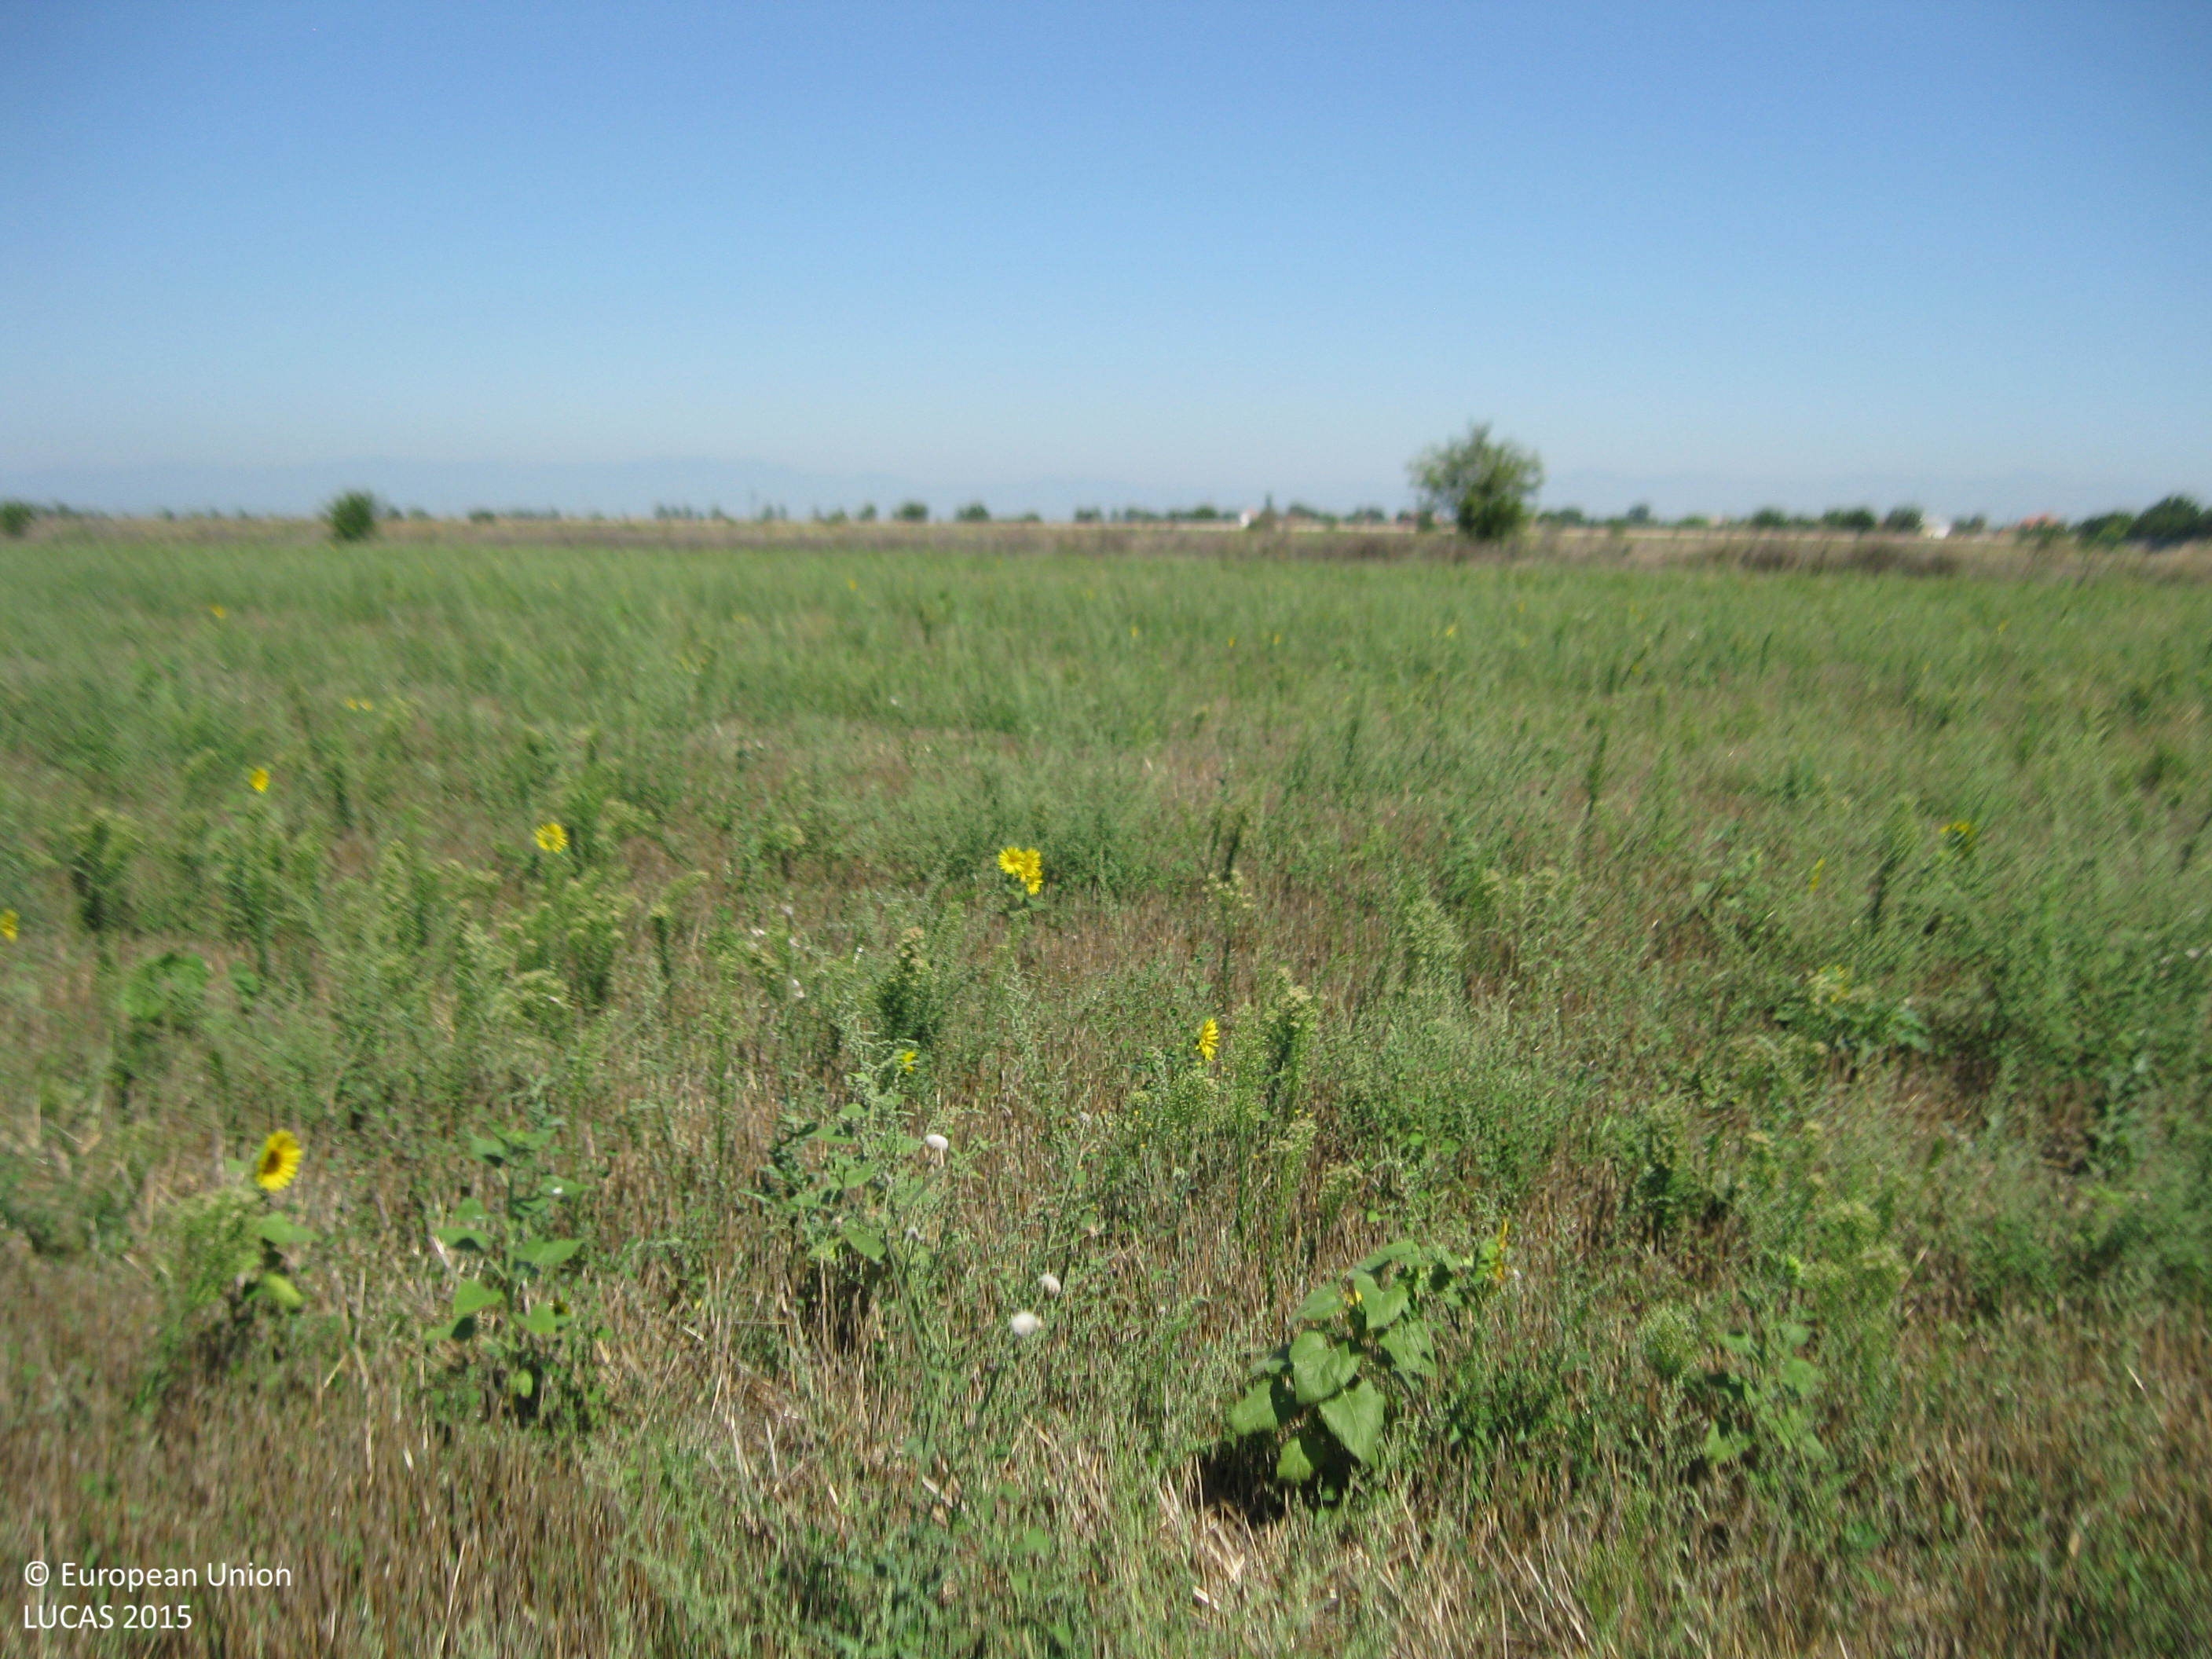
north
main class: Cropland
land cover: Common wheat
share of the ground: 25 - 50 %
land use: Agriculture (excluding fallow land and kitchen gardens)
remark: Harvested field
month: September
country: BG
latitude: 42.2094
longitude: 24.6214
